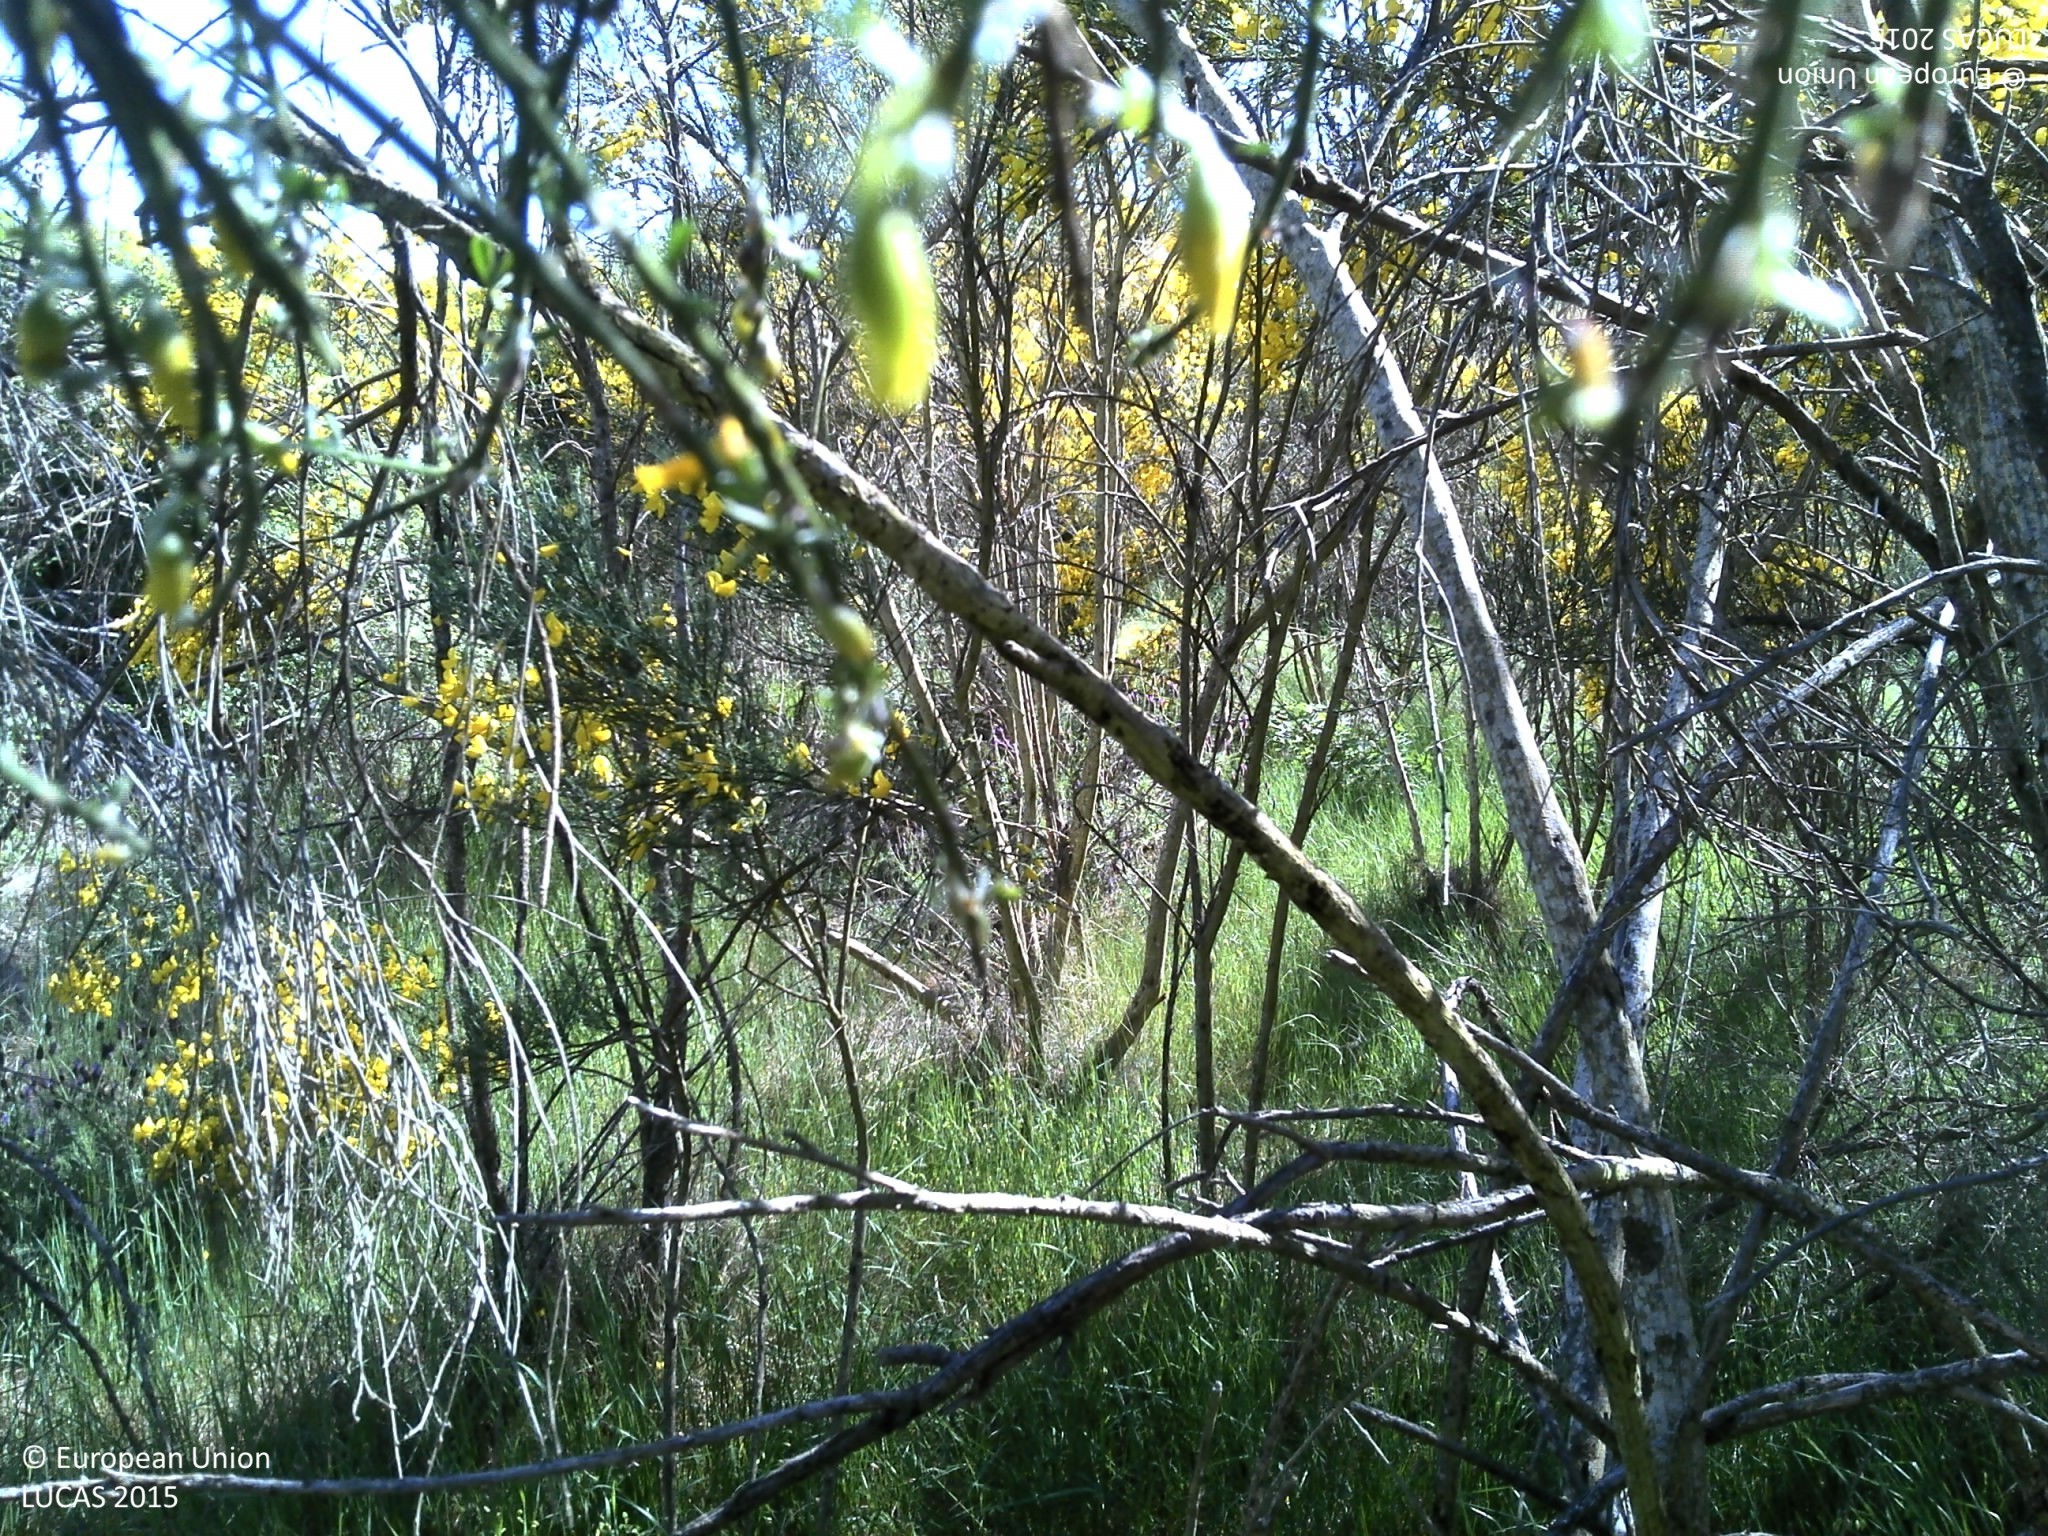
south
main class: Shrubland
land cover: Shrubland without tree cover
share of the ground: 50 - 75 %
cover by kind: shrubs 60 %, herbaceous plants 40 %
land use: Forestry
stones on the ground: < 10 %
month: May
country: PT
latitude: 41.8372
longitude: -7.3858
